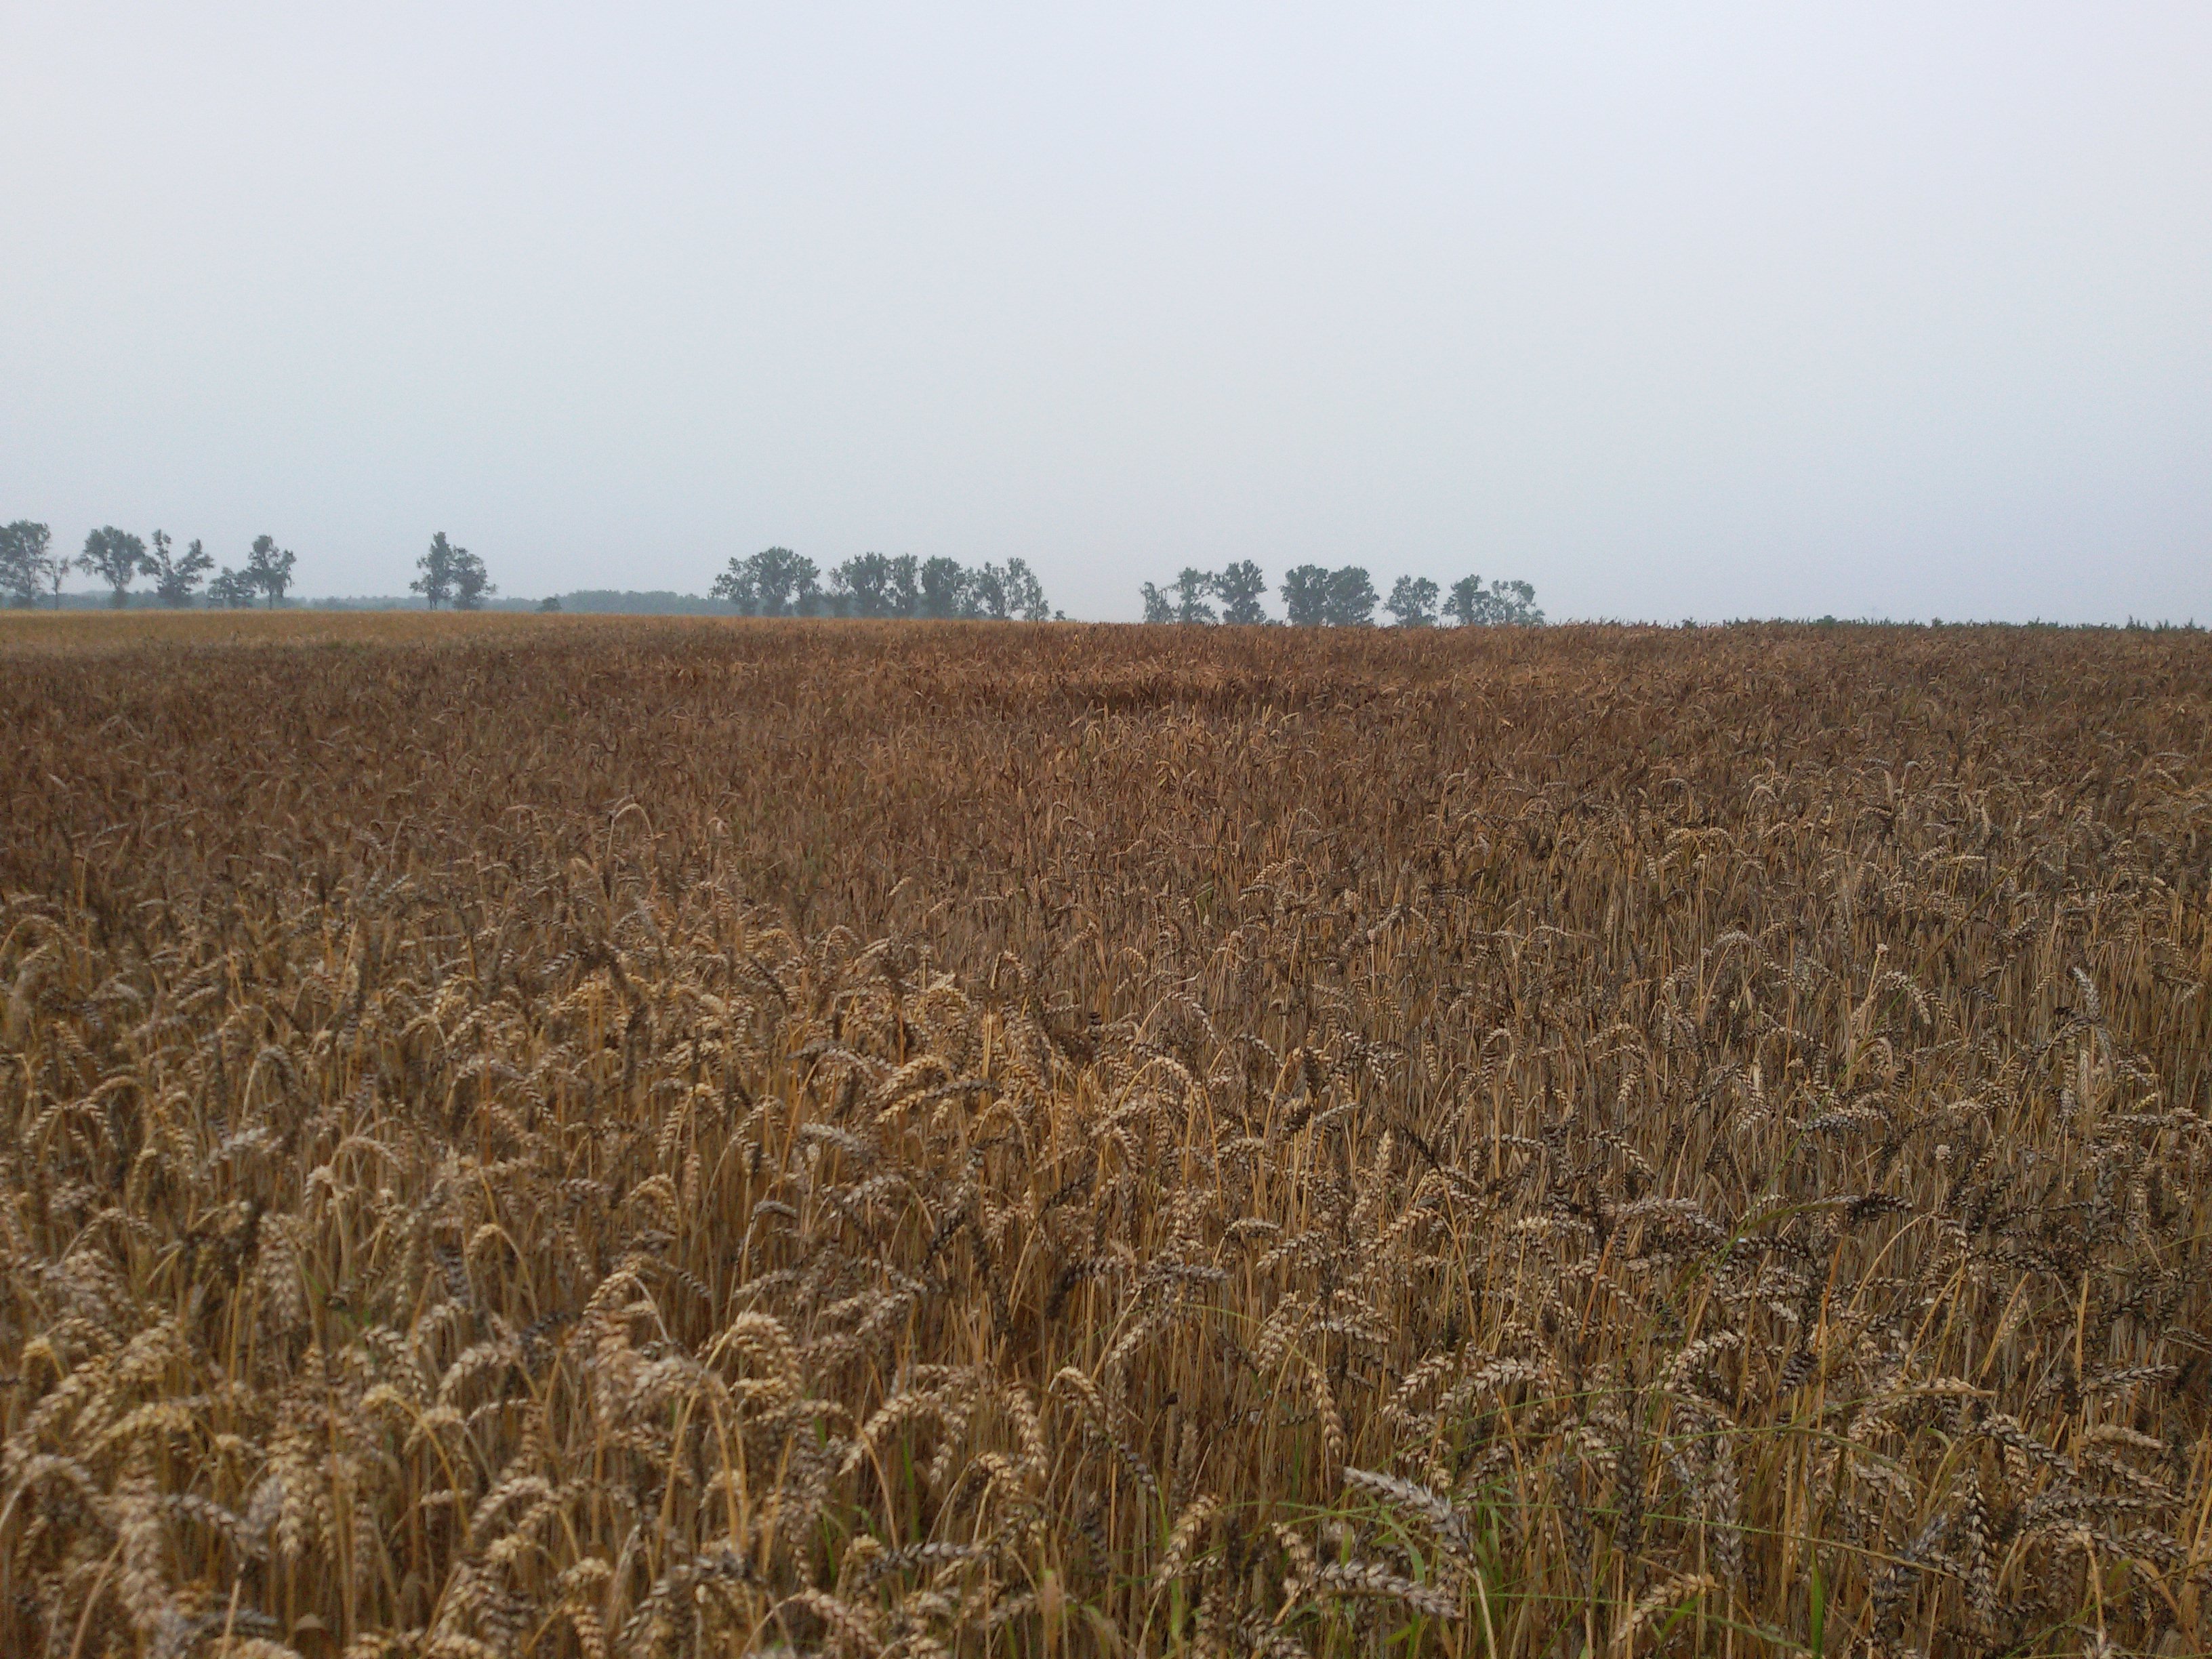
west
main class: Cropland
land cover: Common wheat
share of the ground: > 75 %
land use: Agriculture (excluding fallow land and kitchen gardens)
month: July
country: PL
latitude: 52.2843
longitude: 17.5033
